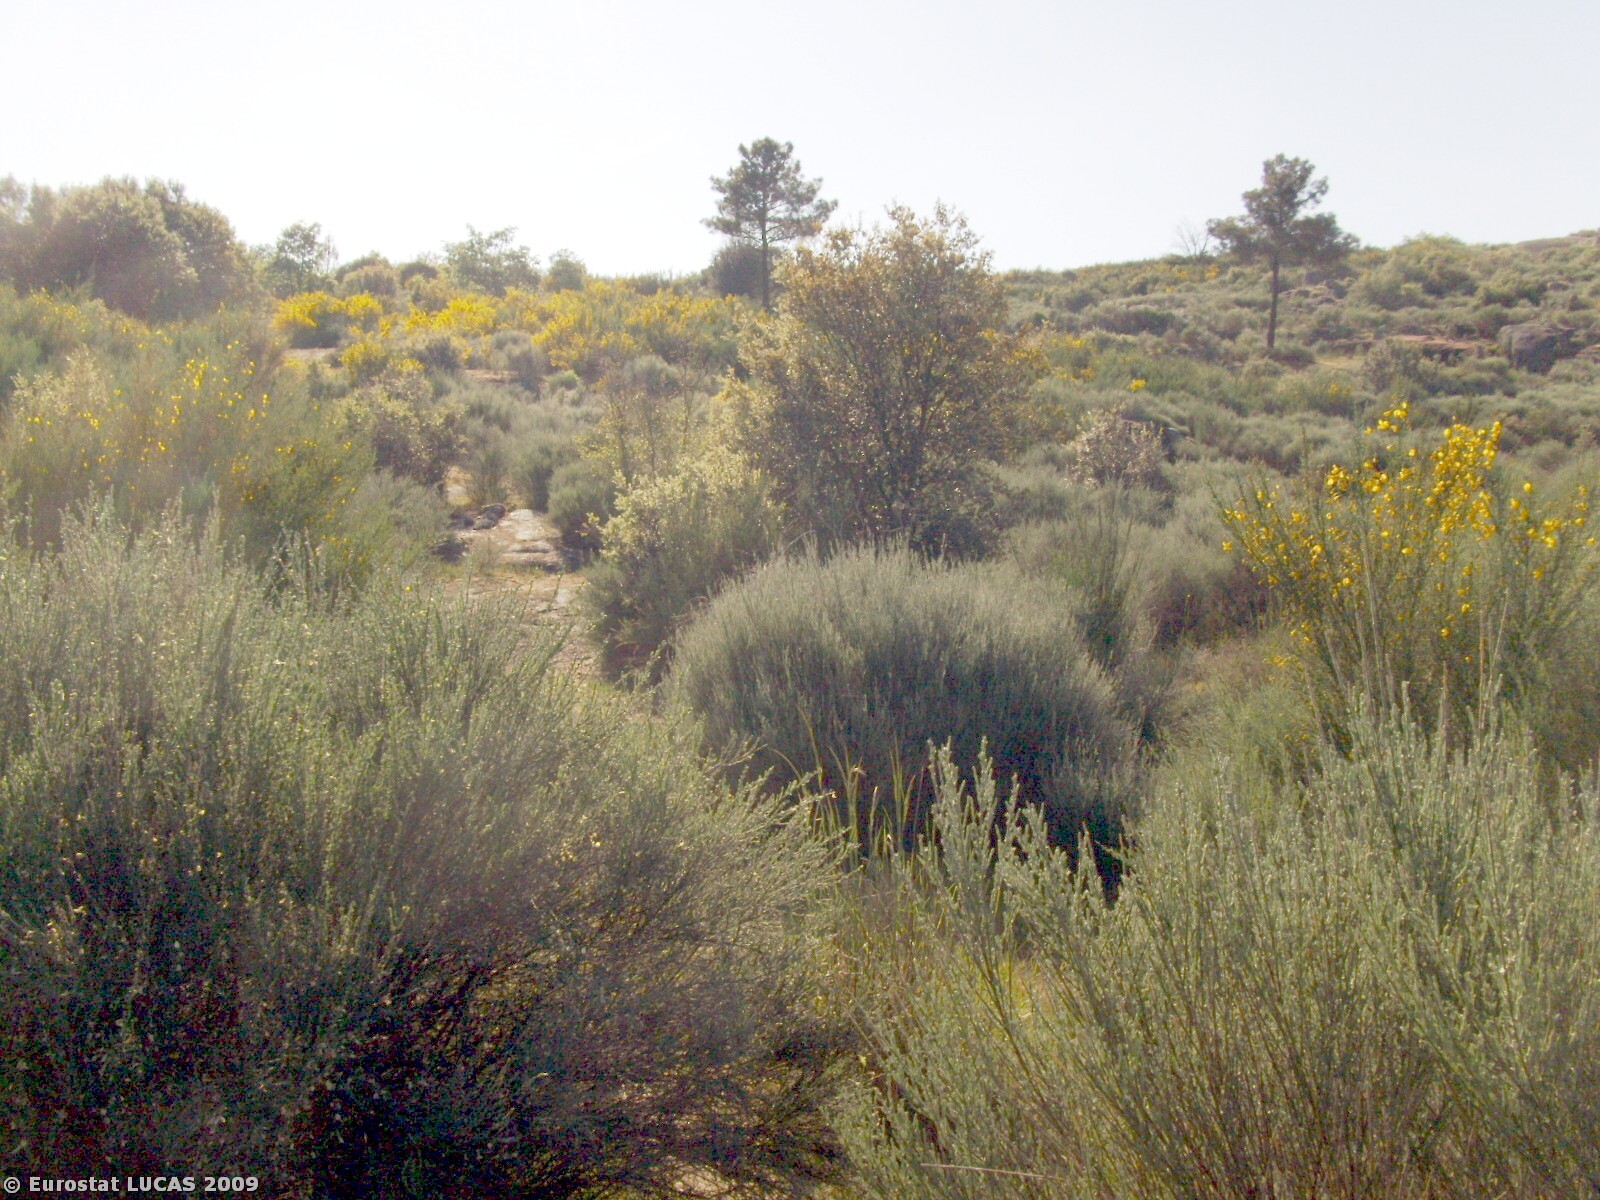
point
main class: Shrubland
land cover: Shrubland with sparse tree cover
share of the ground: > 75 %
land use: Nature reserves
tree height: > 5 m
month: May
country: PT
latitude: 40.6080
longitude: -7.3527
